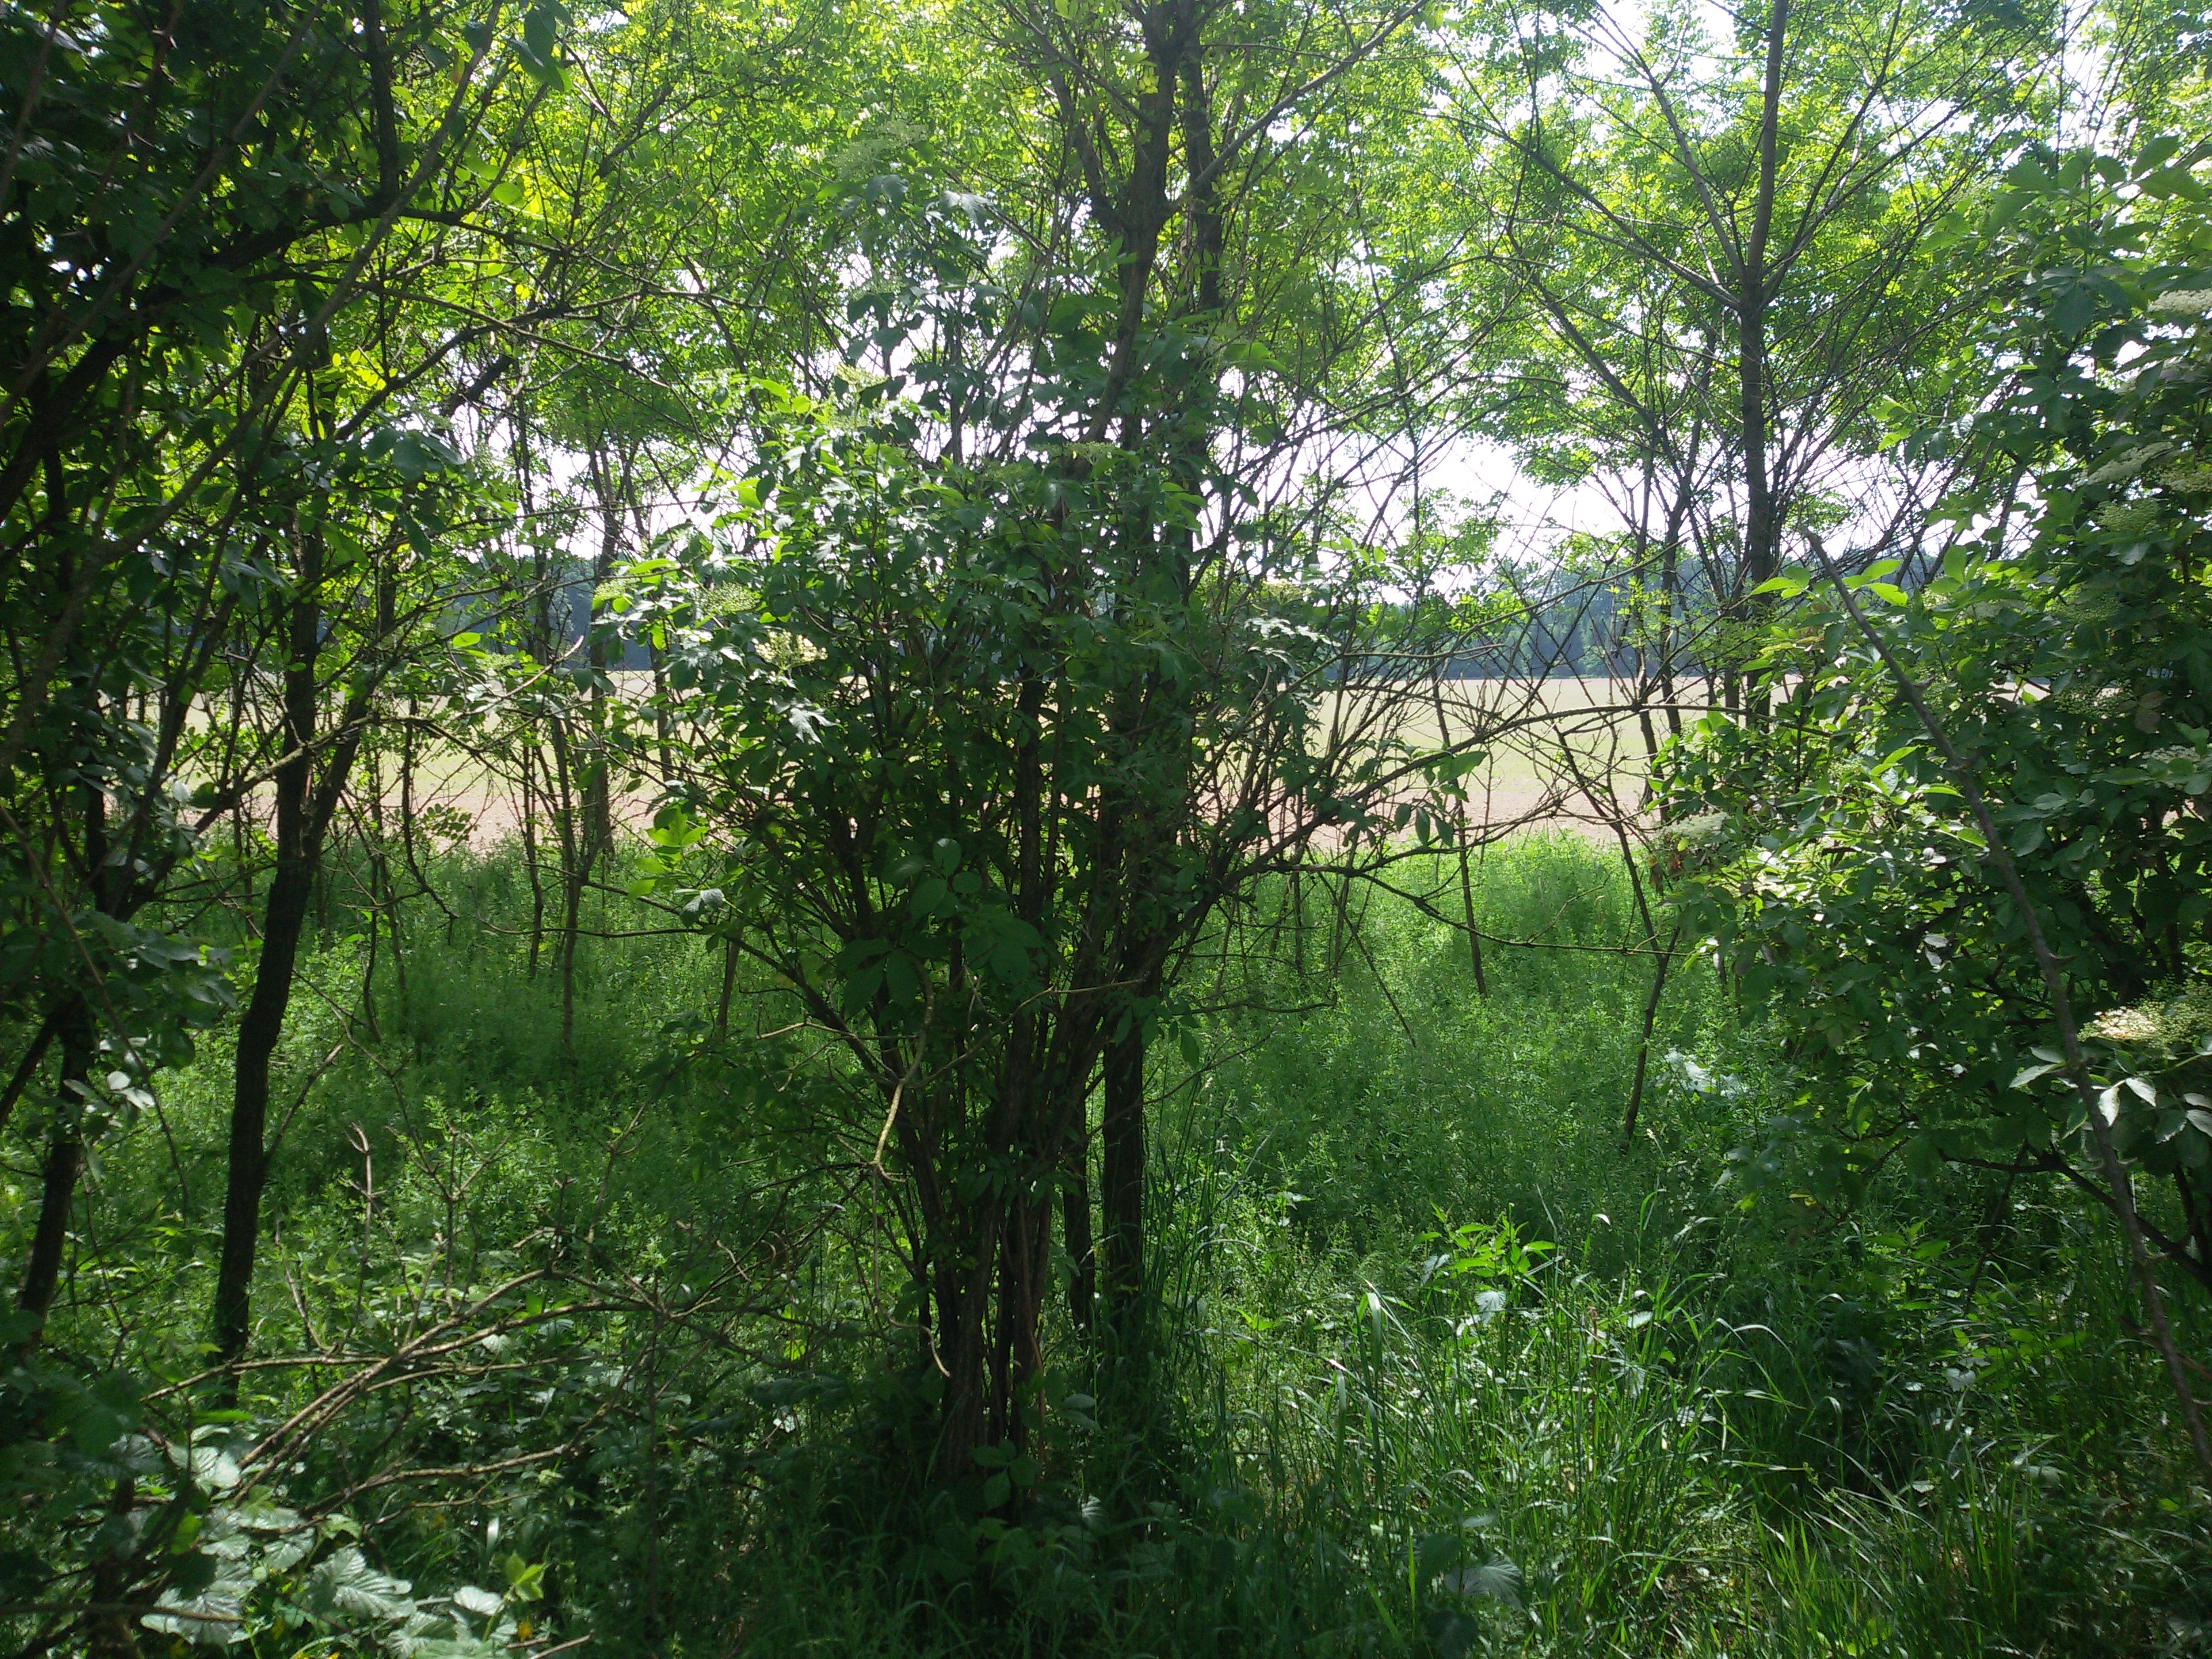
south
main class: Woodland
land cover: Broadleaved woodland
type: mesophytic deciduous forest
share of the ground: > 75 %
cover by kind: broadleaved forest trees 75 %, shrubs 10 %, herbaceous plants 10 %
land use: Semi-natural and natural areas not in use
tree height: > 5 m
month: May
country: PL
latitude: 50.6384
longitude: 17.2651
